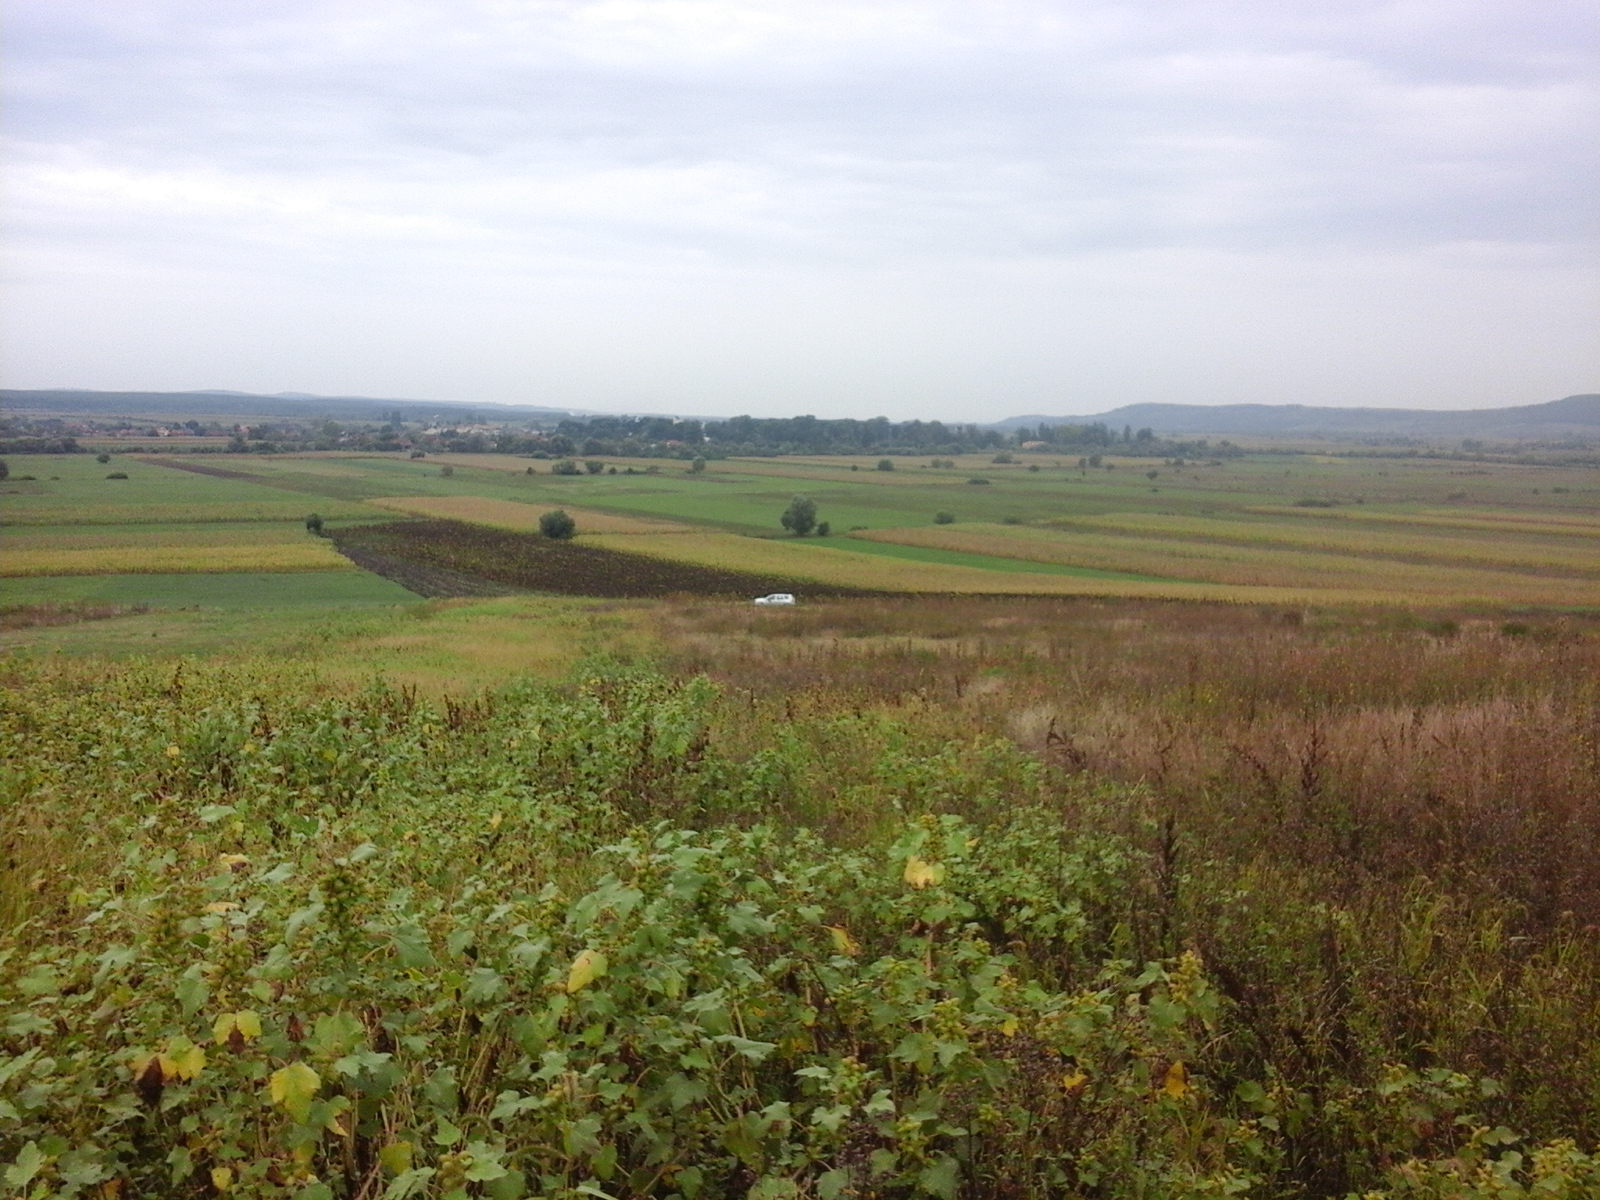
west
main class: Grassland
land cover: Spontaneously vegetated surfaces
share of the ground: > 75 %
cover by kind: herbaceous plants 100 %
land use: Fallow land
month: September
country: RO
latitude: 47.3021
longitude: 22.5551
